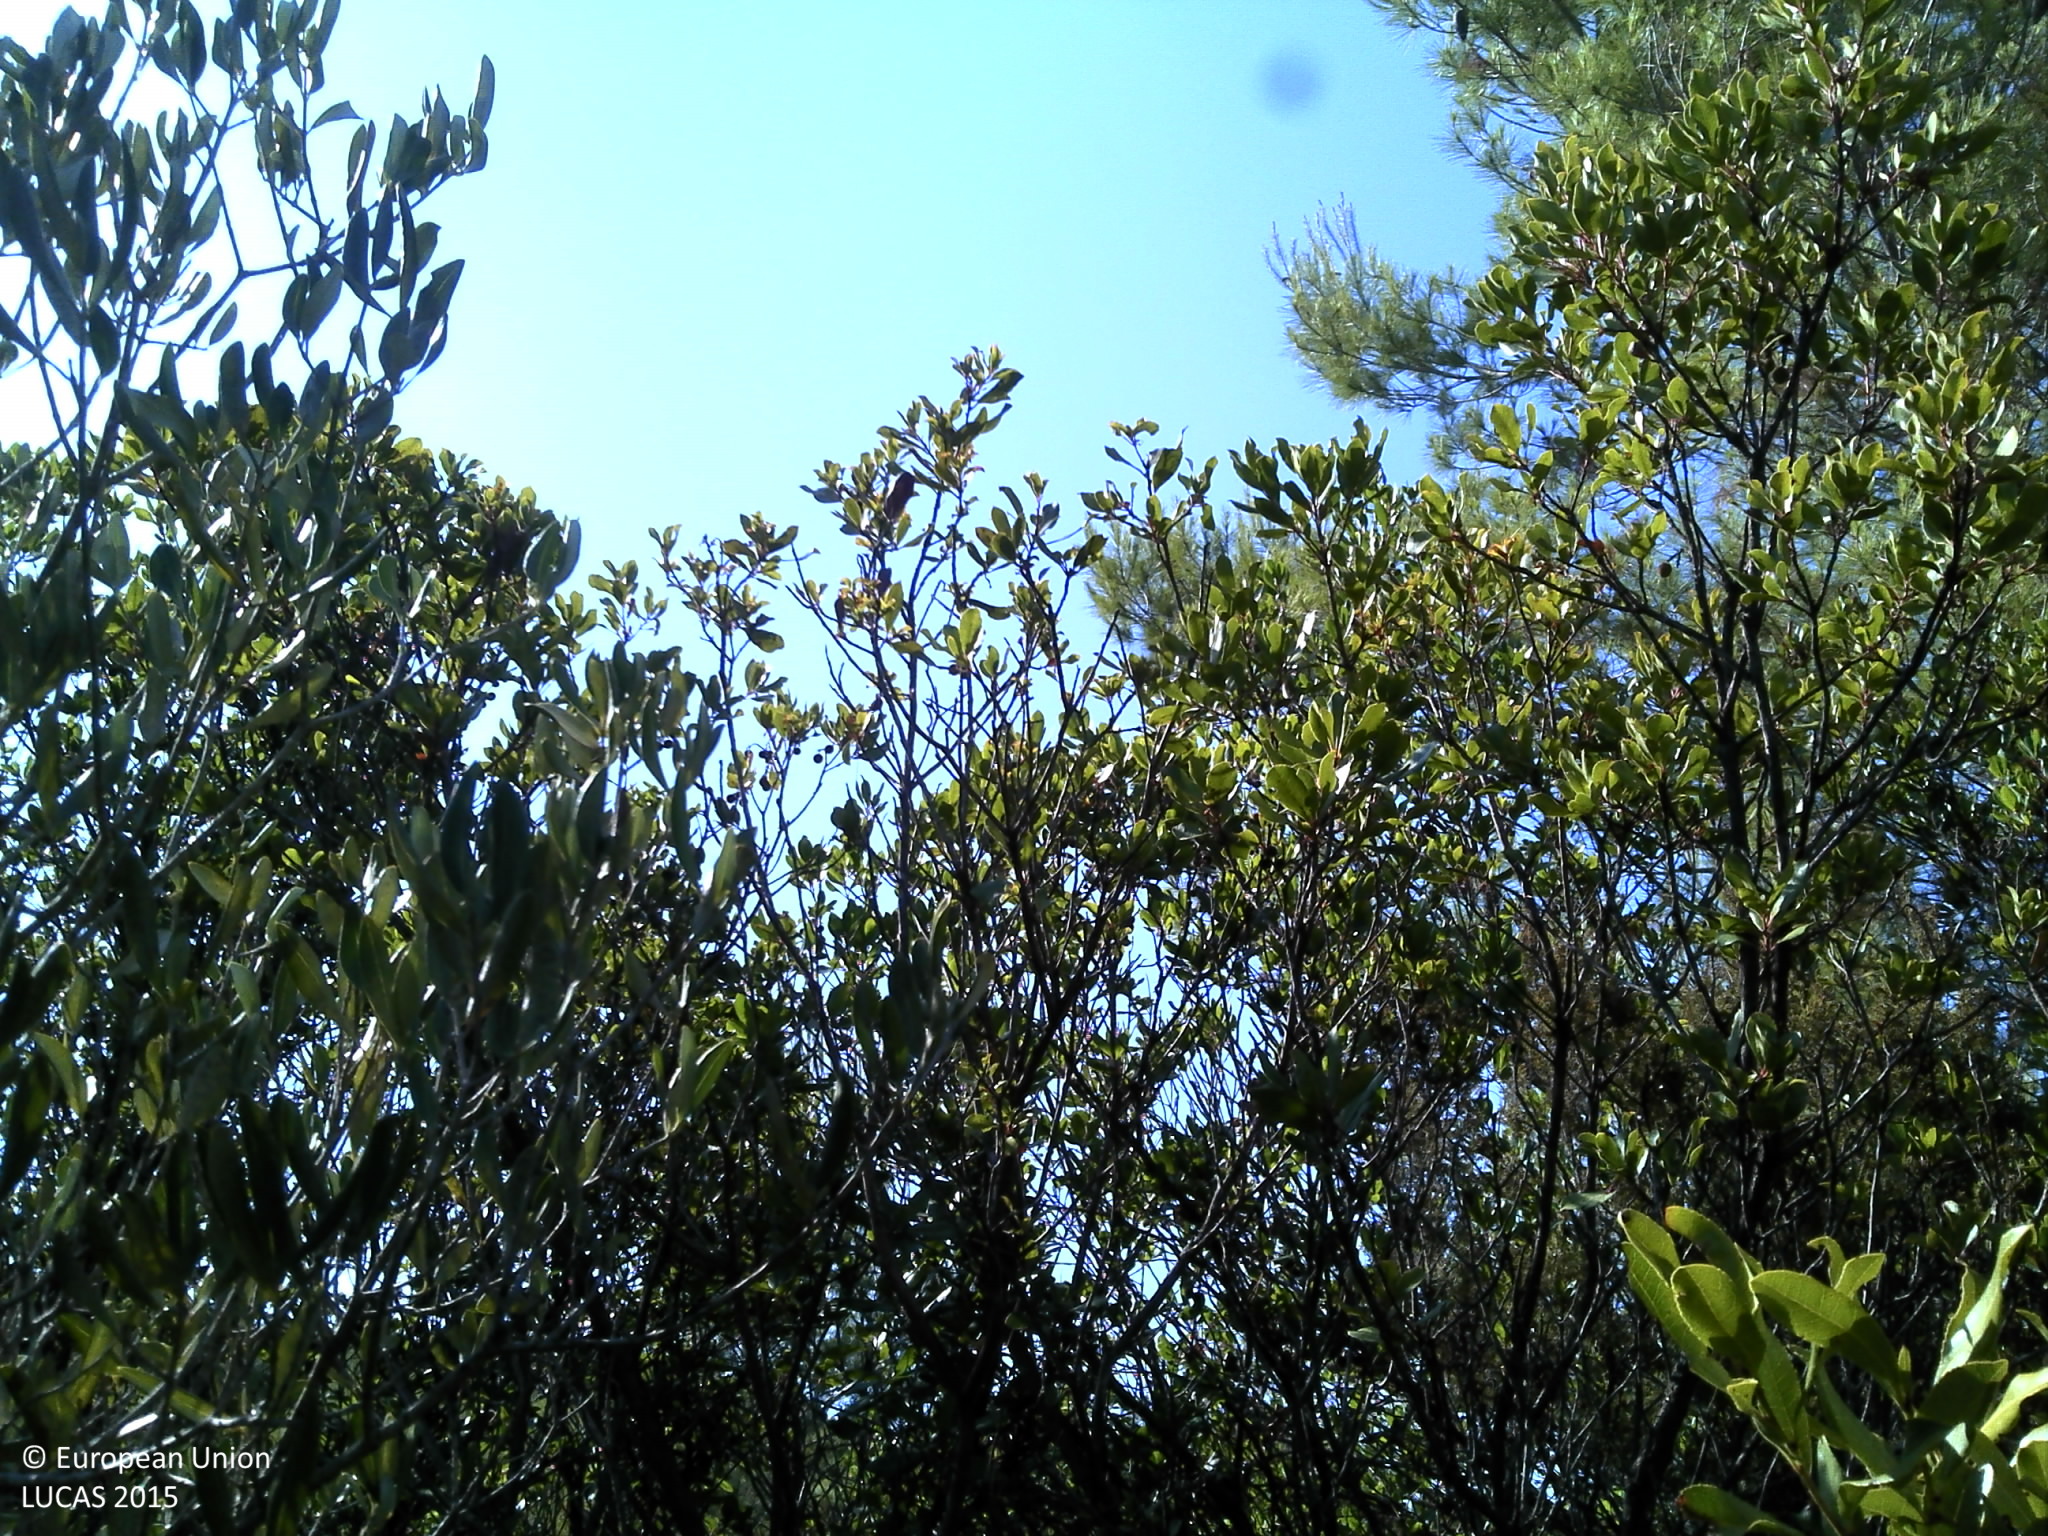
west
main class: Cropland
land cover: Olive groves
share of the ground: > 75 %
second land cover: Shrubland without tree cover
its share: > 75 %
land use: Agriculture (excluding fallow land and kitchen gardens)
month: August
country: HR
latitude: 42.9234
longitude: 16.9355
